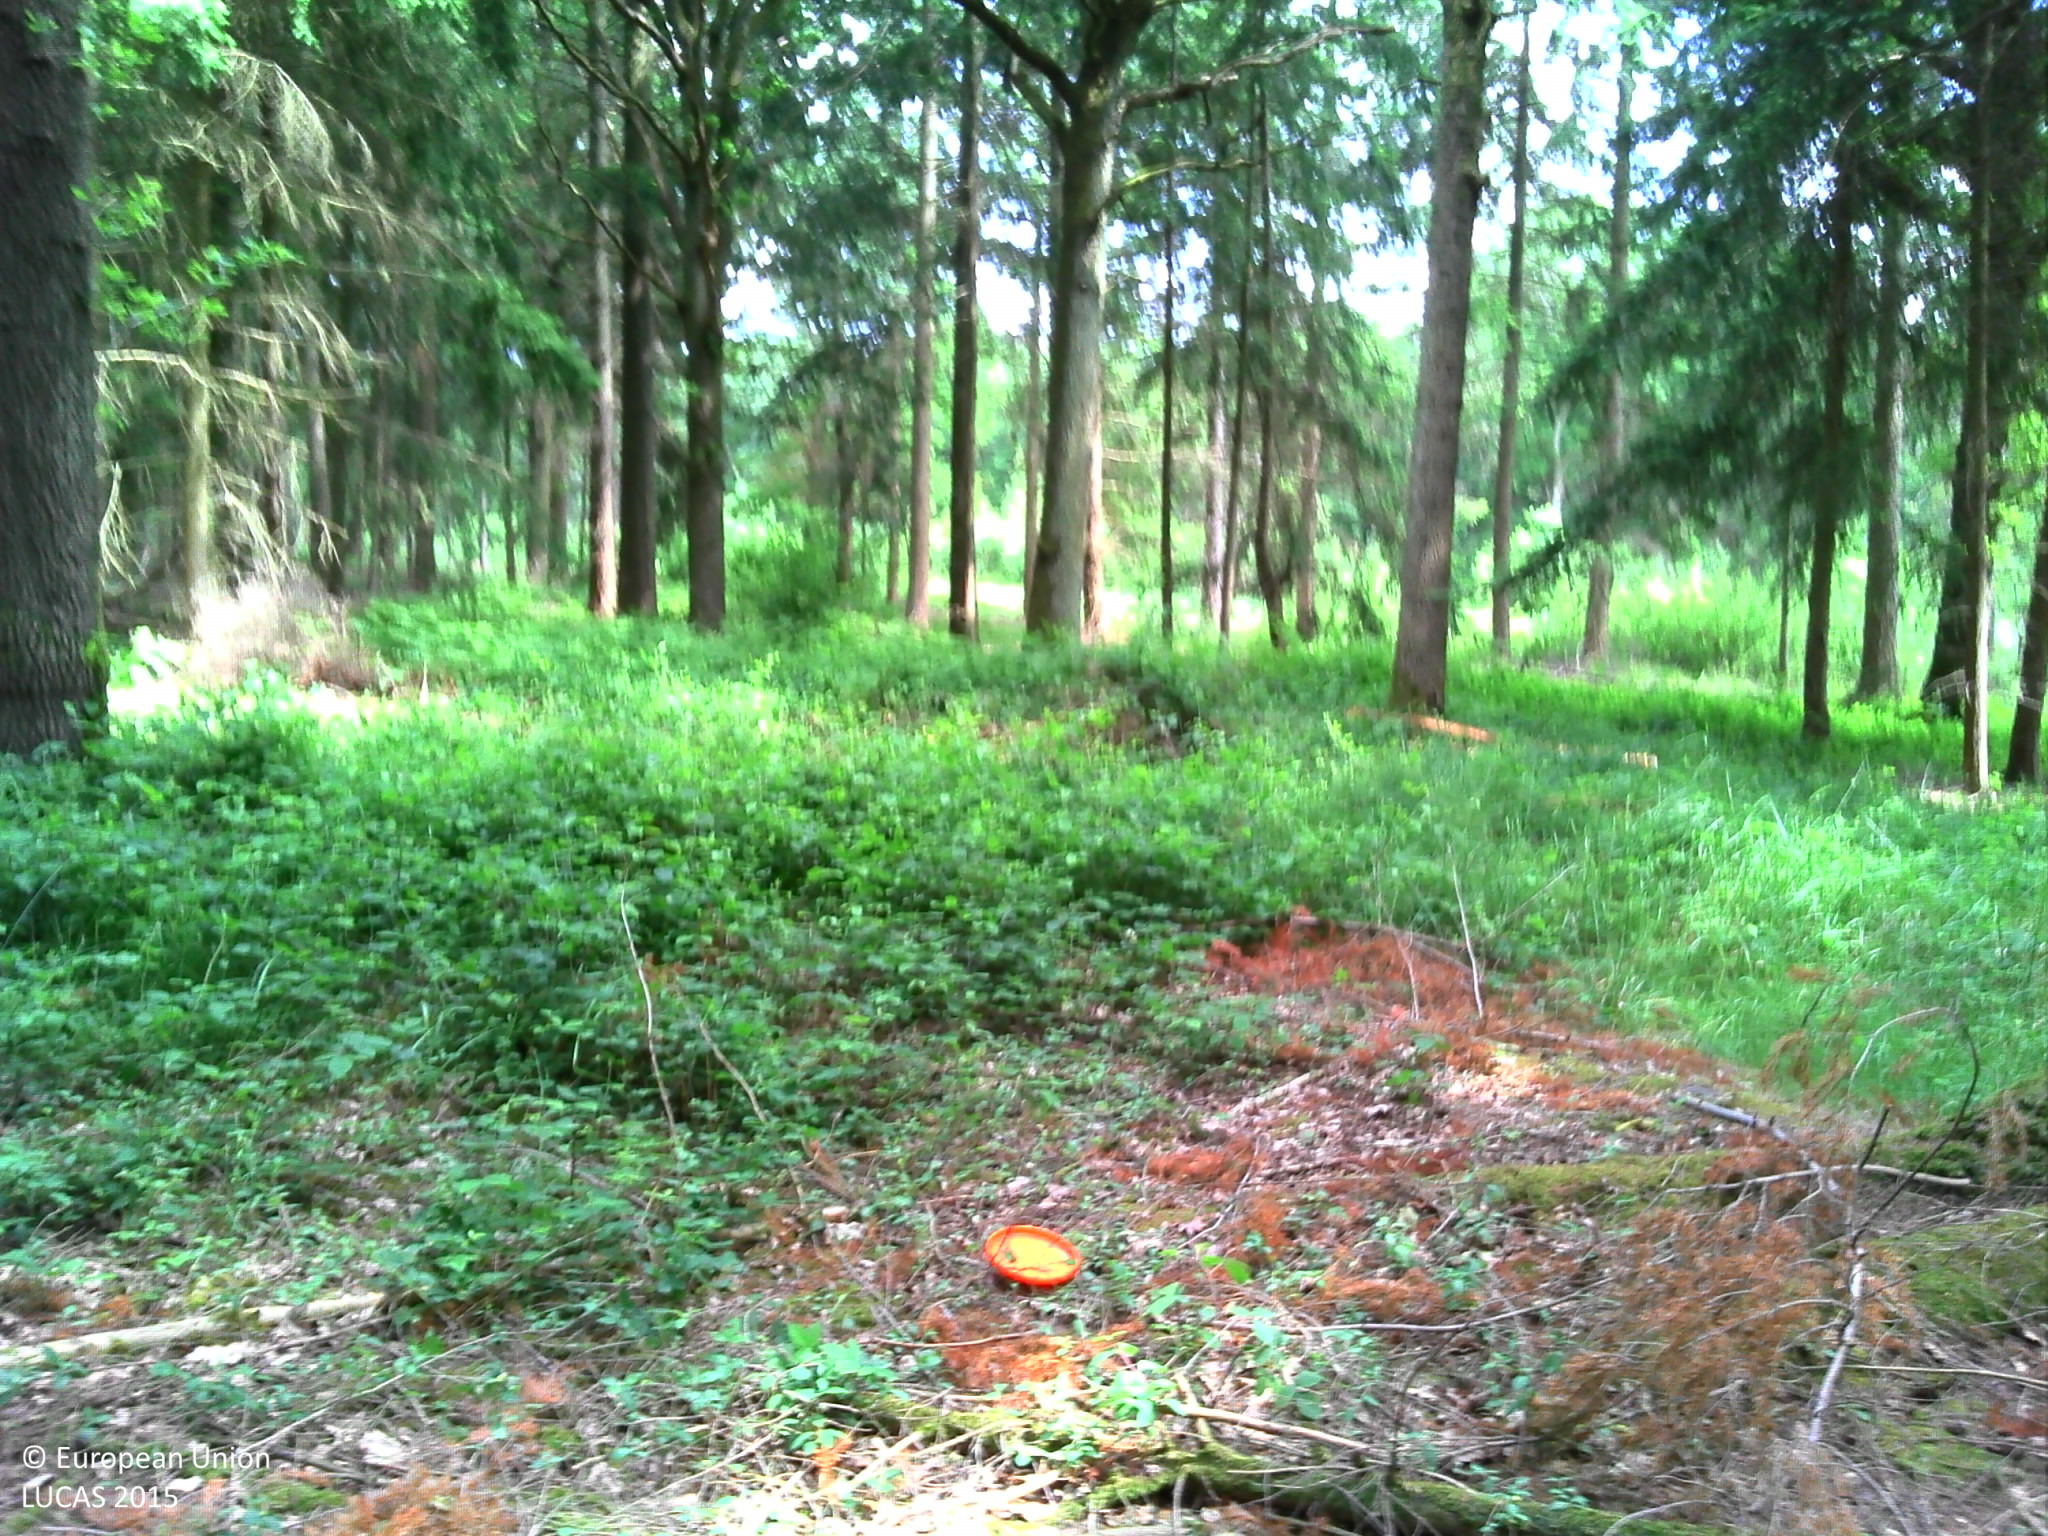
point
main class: Woodland
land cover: Pine dominated mixed woodland
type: exotic forest
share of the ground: > 75 %
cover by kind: coniferous forest trees 60 %, broadleaved forest trees 25 %, lichens and mosses 10 %, herbaceous plants 5 %
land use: Forestry
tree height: > 5 m
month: June
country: FR
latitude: 50.7557
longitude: 2.3174
